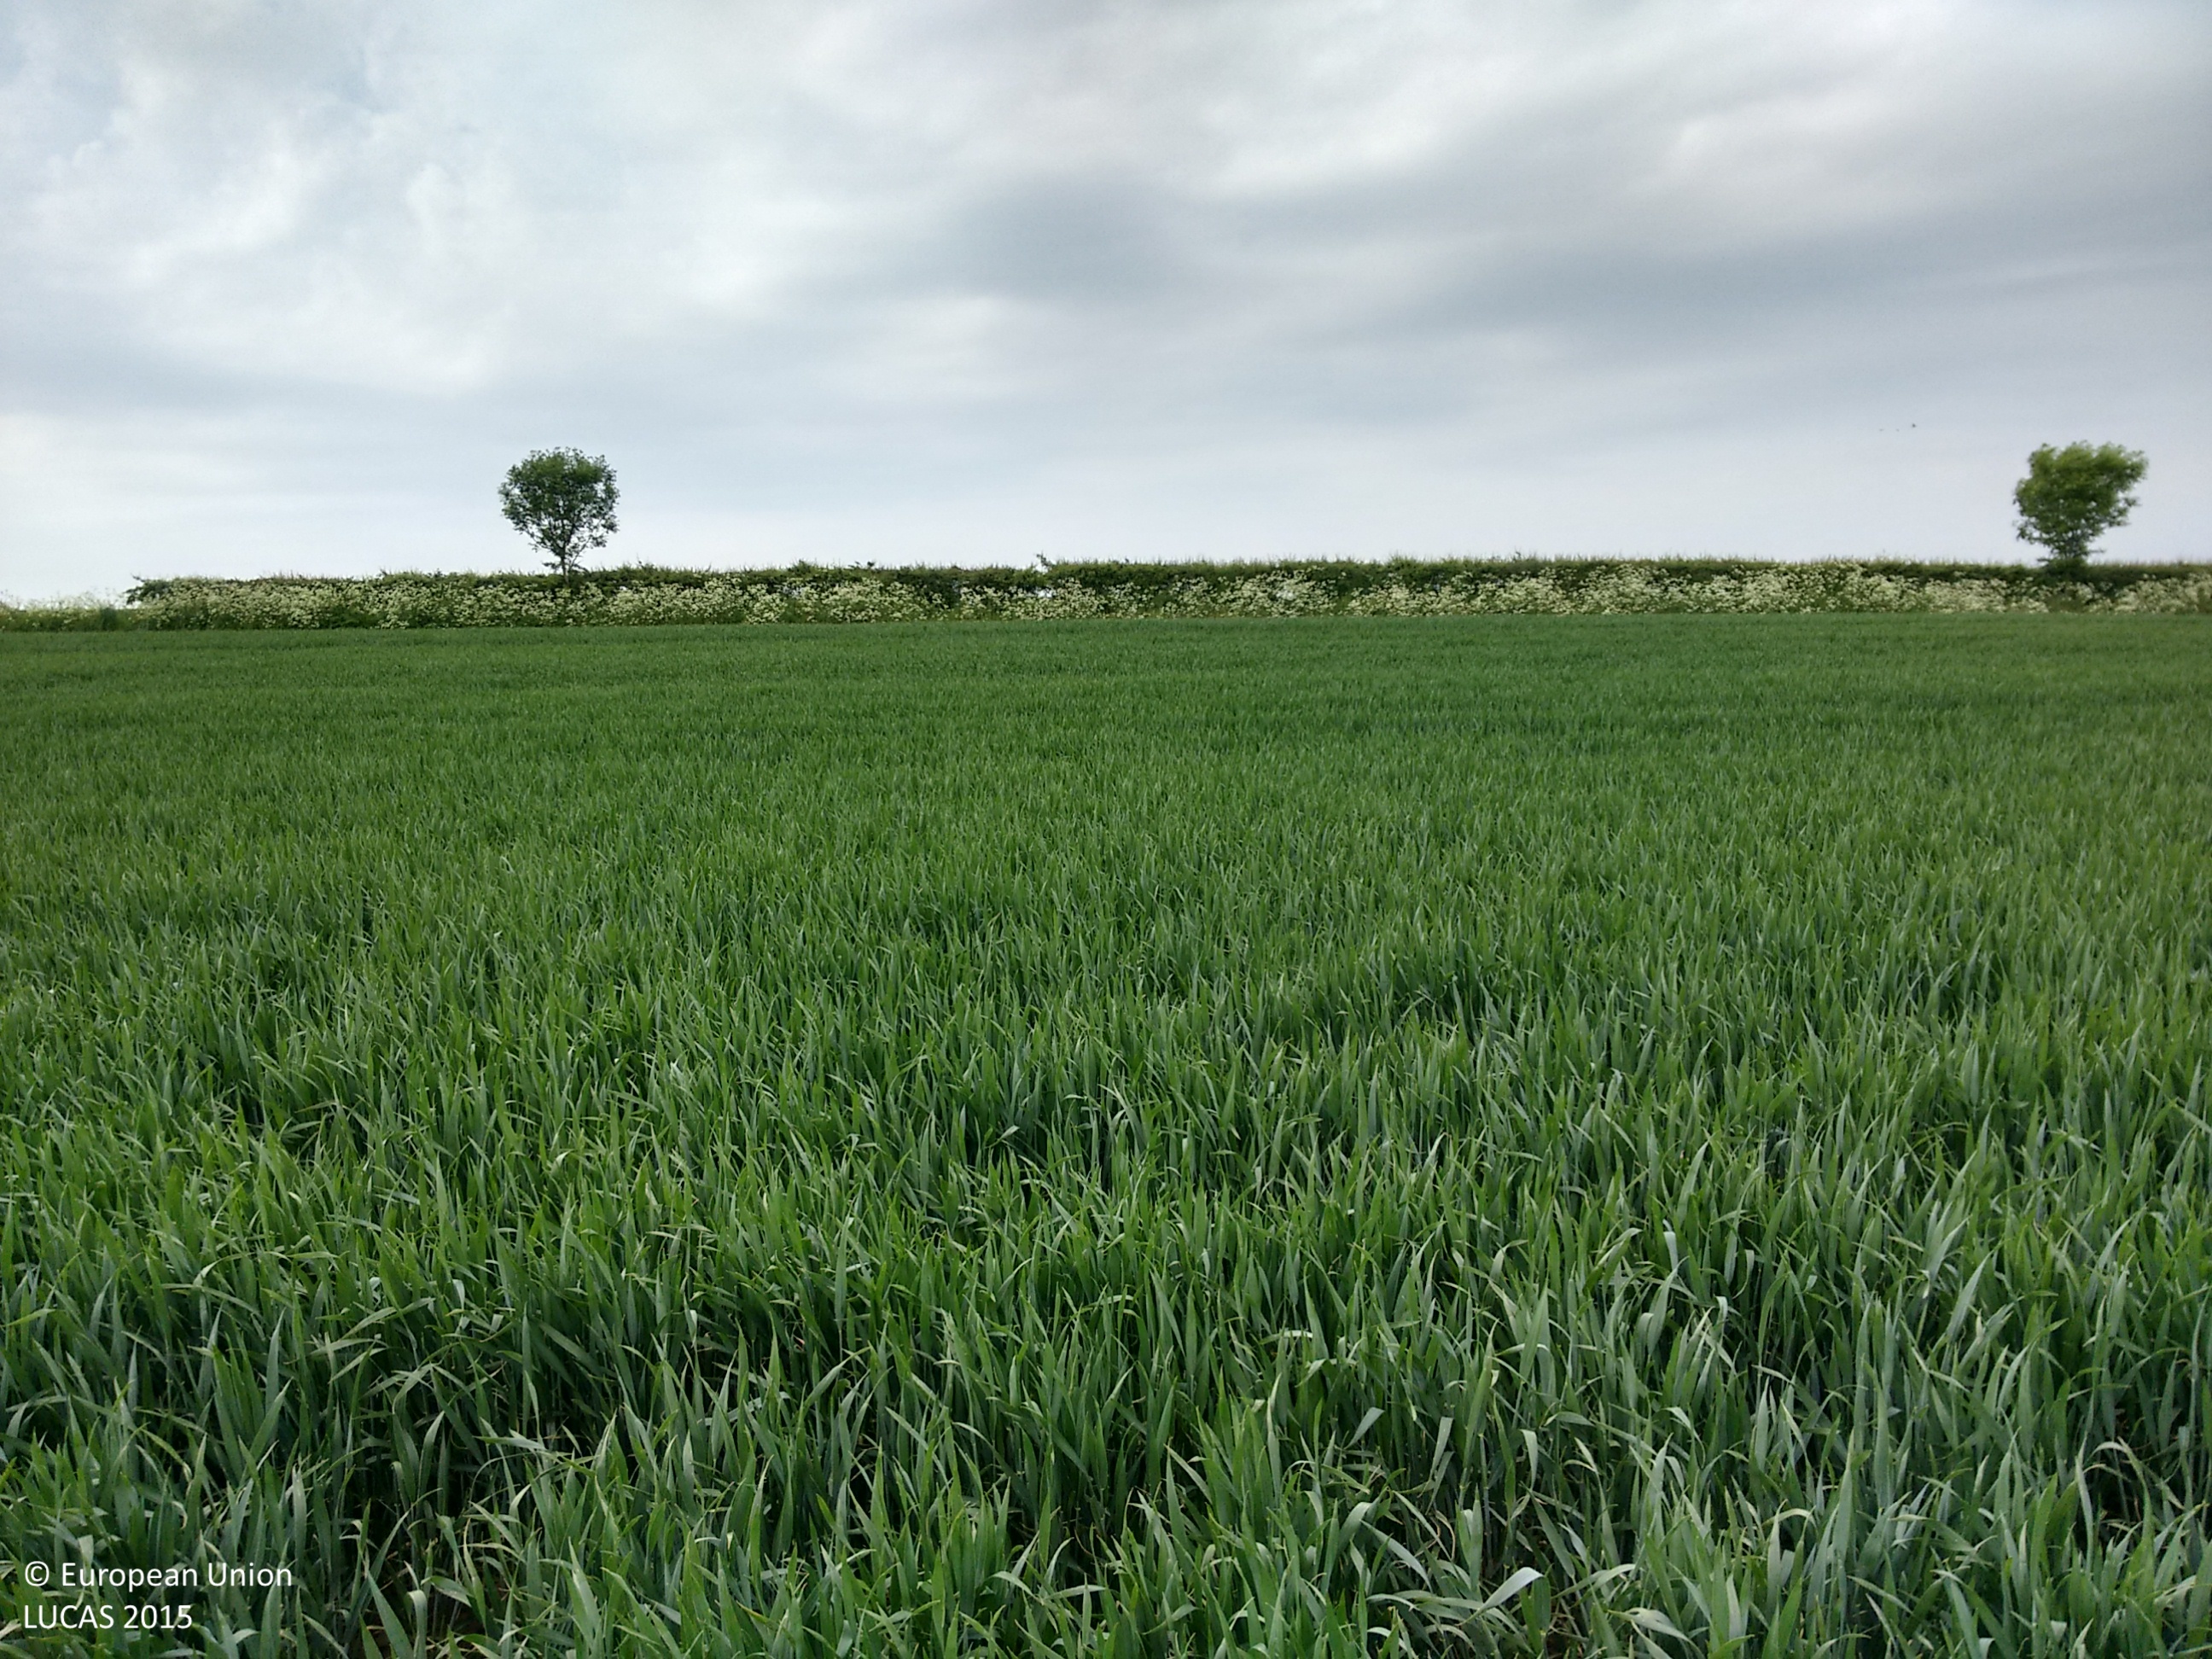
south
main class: Cropland
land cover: Common wheat
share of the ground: > 75 %
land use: Agriculture (excluding fallow land and kitchen gardens)
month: November
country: GB
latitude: 53.9915
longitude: -1.1639
